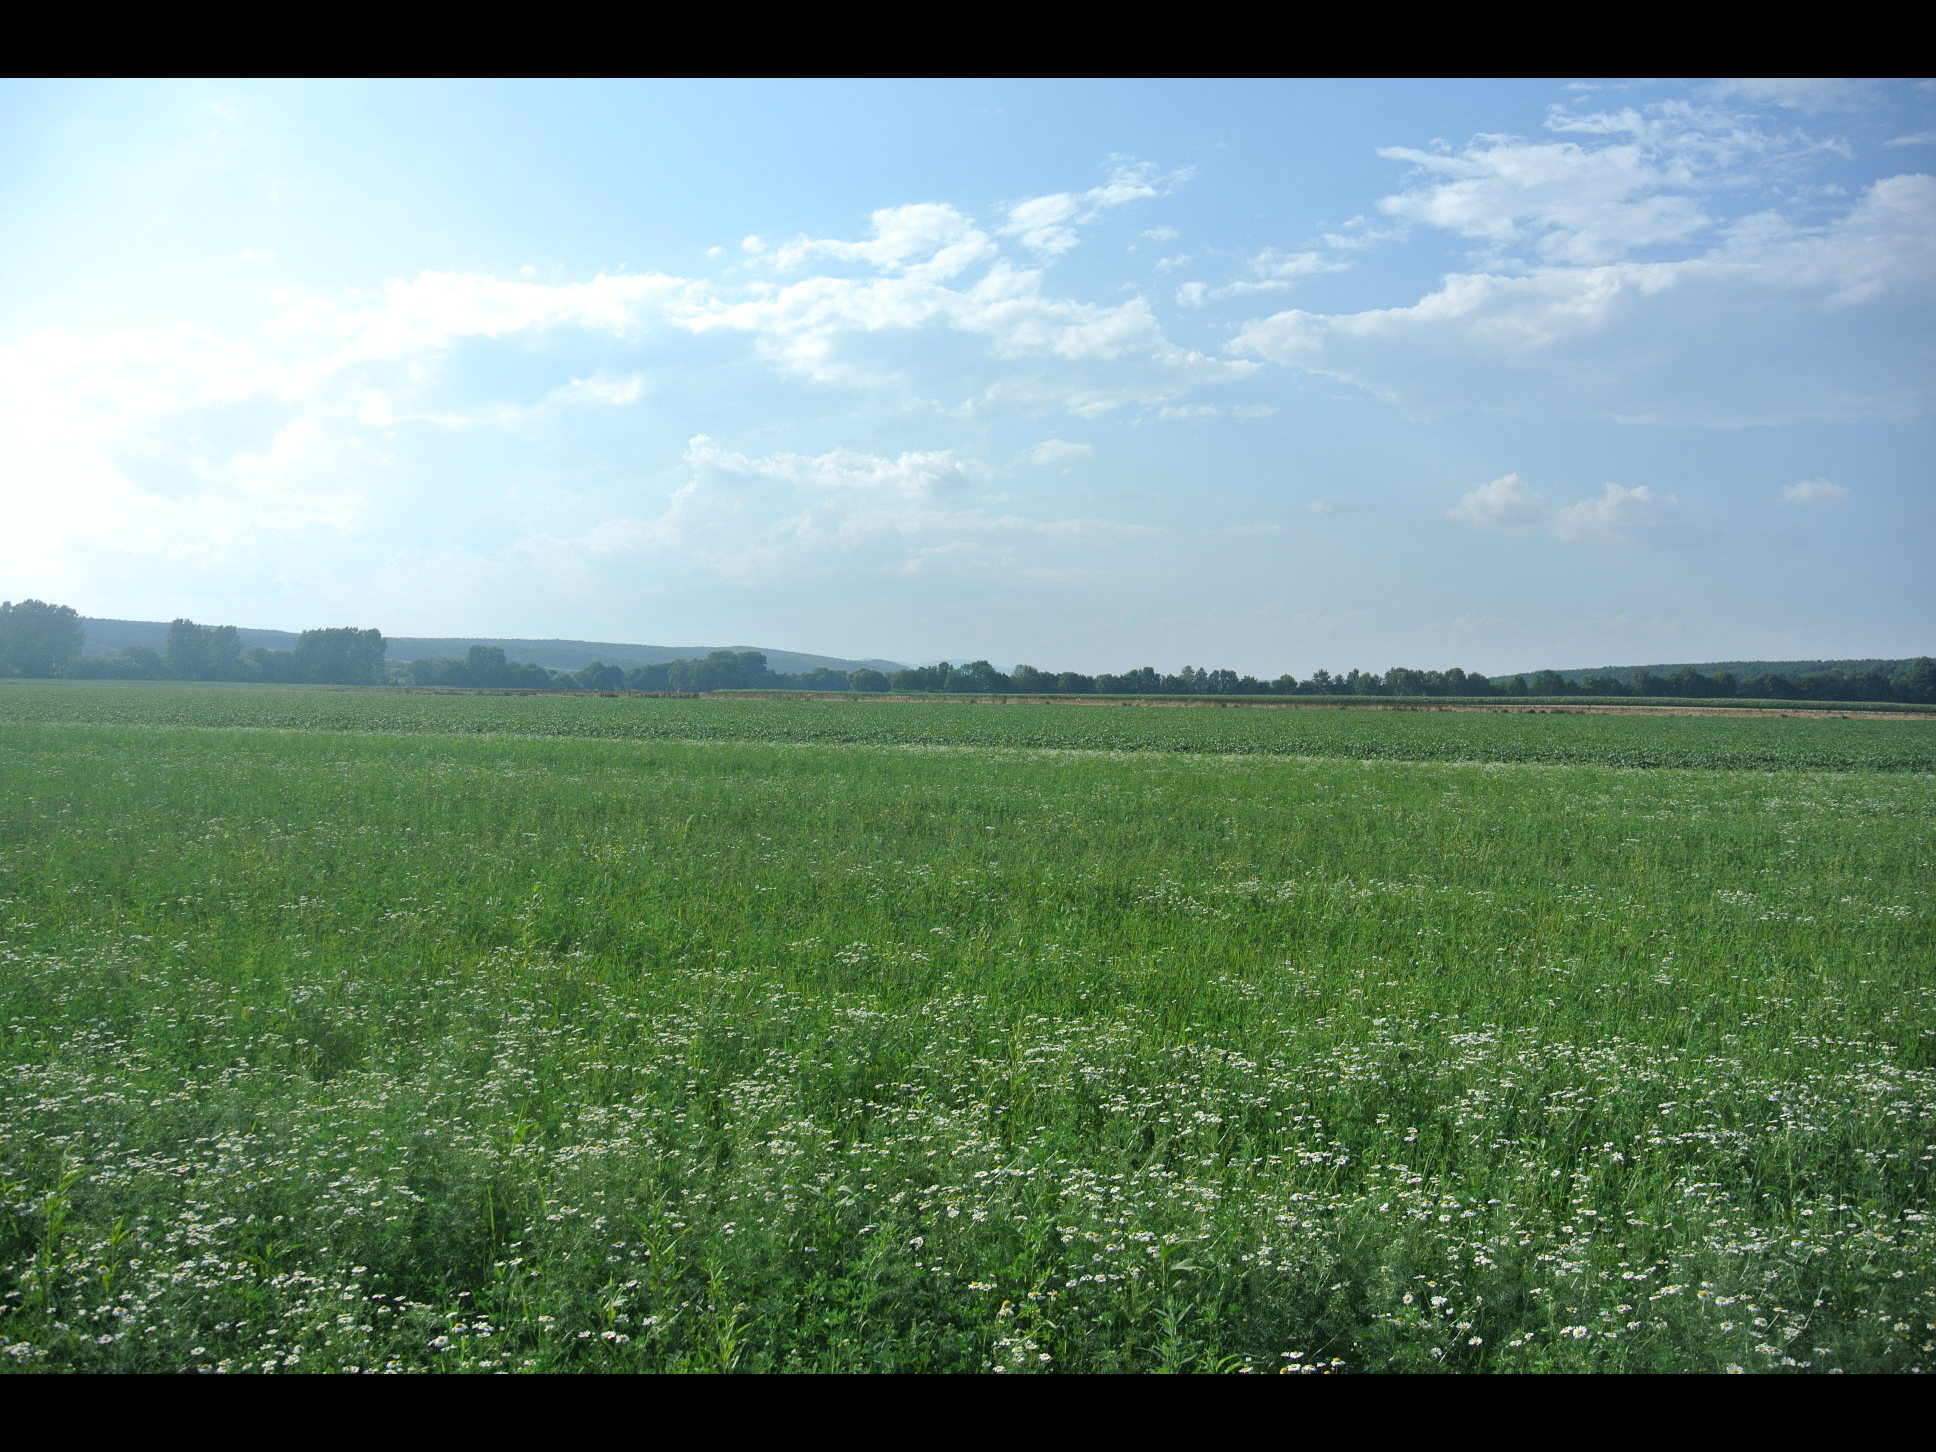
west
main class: Grassland
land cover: Grassland without tree/shrub cover
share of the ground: > 75 %
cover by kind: herbaceous plants 100 %
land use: Agriculture (excluding fallow land and kitchen gardens)
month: July
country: AT
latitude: 47.4530
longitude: 16.5161
